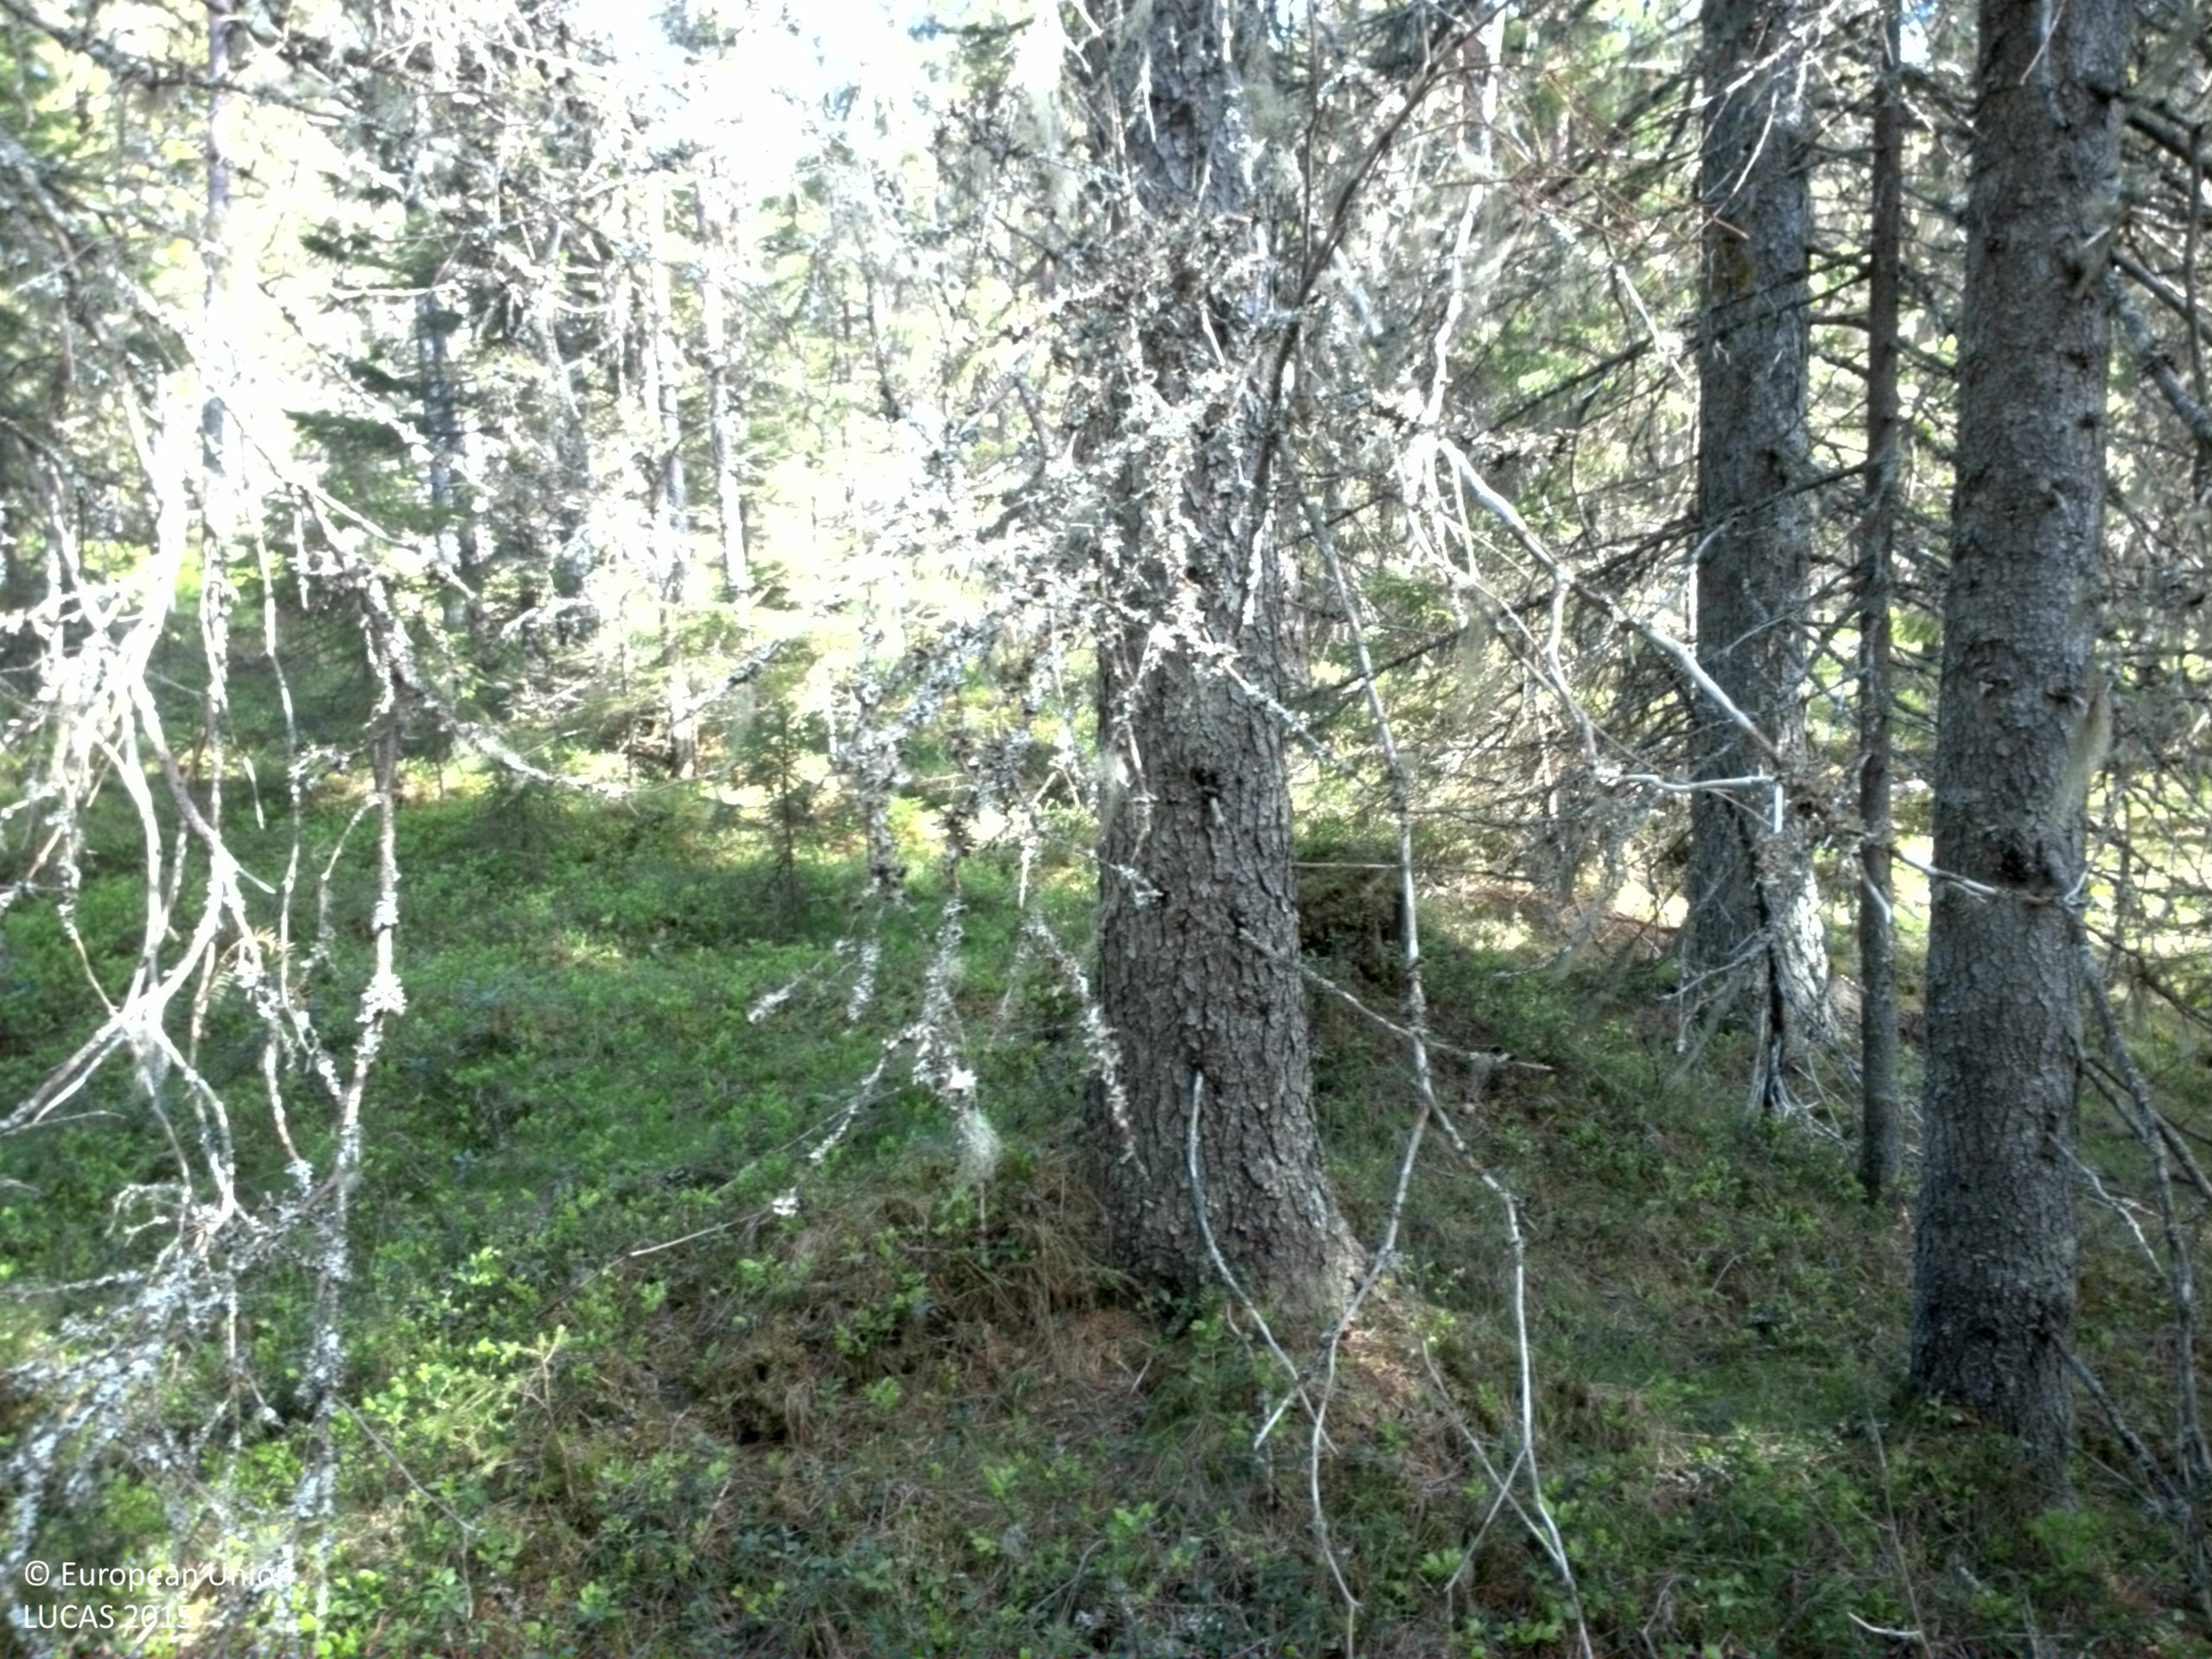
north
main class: Woodland
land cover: Spruce dominated coniferous woodland
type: boreal forest
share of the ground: > 75 %
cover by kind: coniferous forest trees 85 %, shrubs 15 %
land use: Forestry
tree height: > 5 m
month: May
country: SE
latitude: 62.8219
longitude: 18.2417
